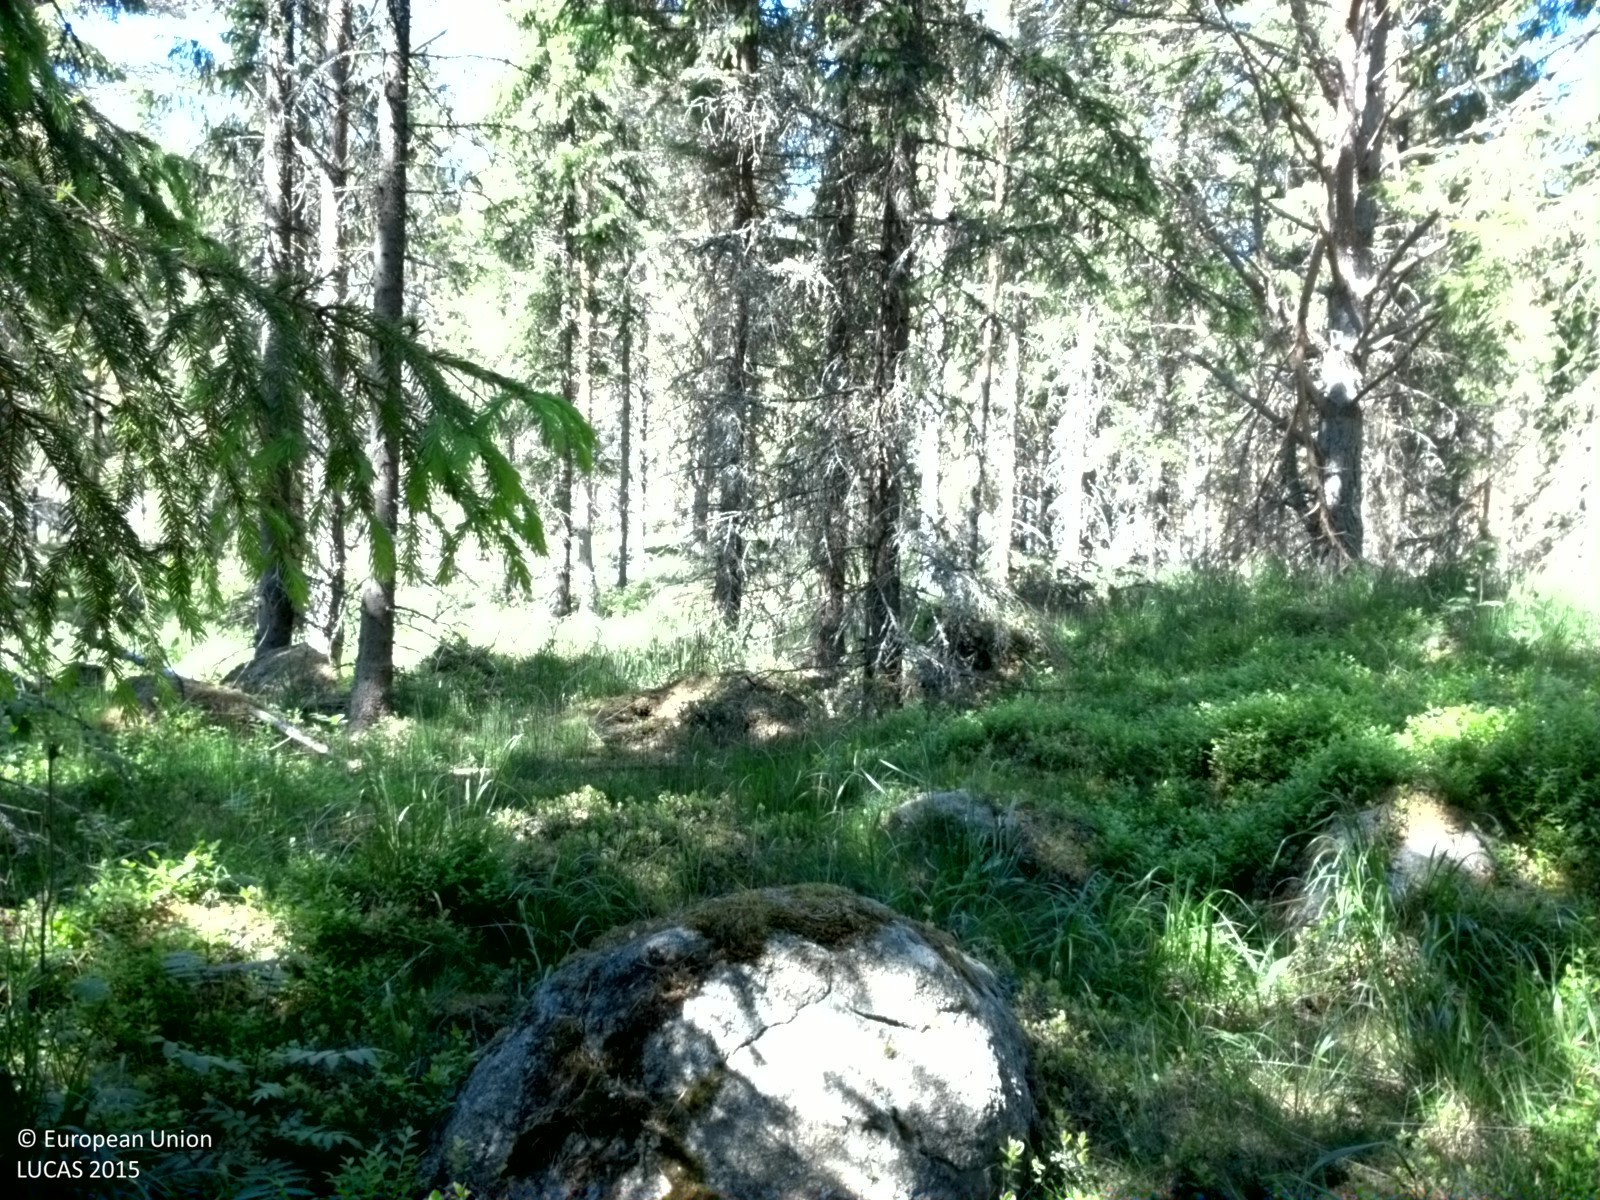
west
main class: Woodland
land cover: Spruce dominated coniferous woodland
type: boreal forest
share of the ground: > 75 %
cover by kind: coniferous forest trees 75 %, herbaceous plants 10 %, shrubs 5 %, lichens and mosses 5 %, consolidated bare surface 5 %
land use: Forestry
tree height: > 5 m
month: June
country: SE
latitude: 60.2670
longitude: 17.5661
